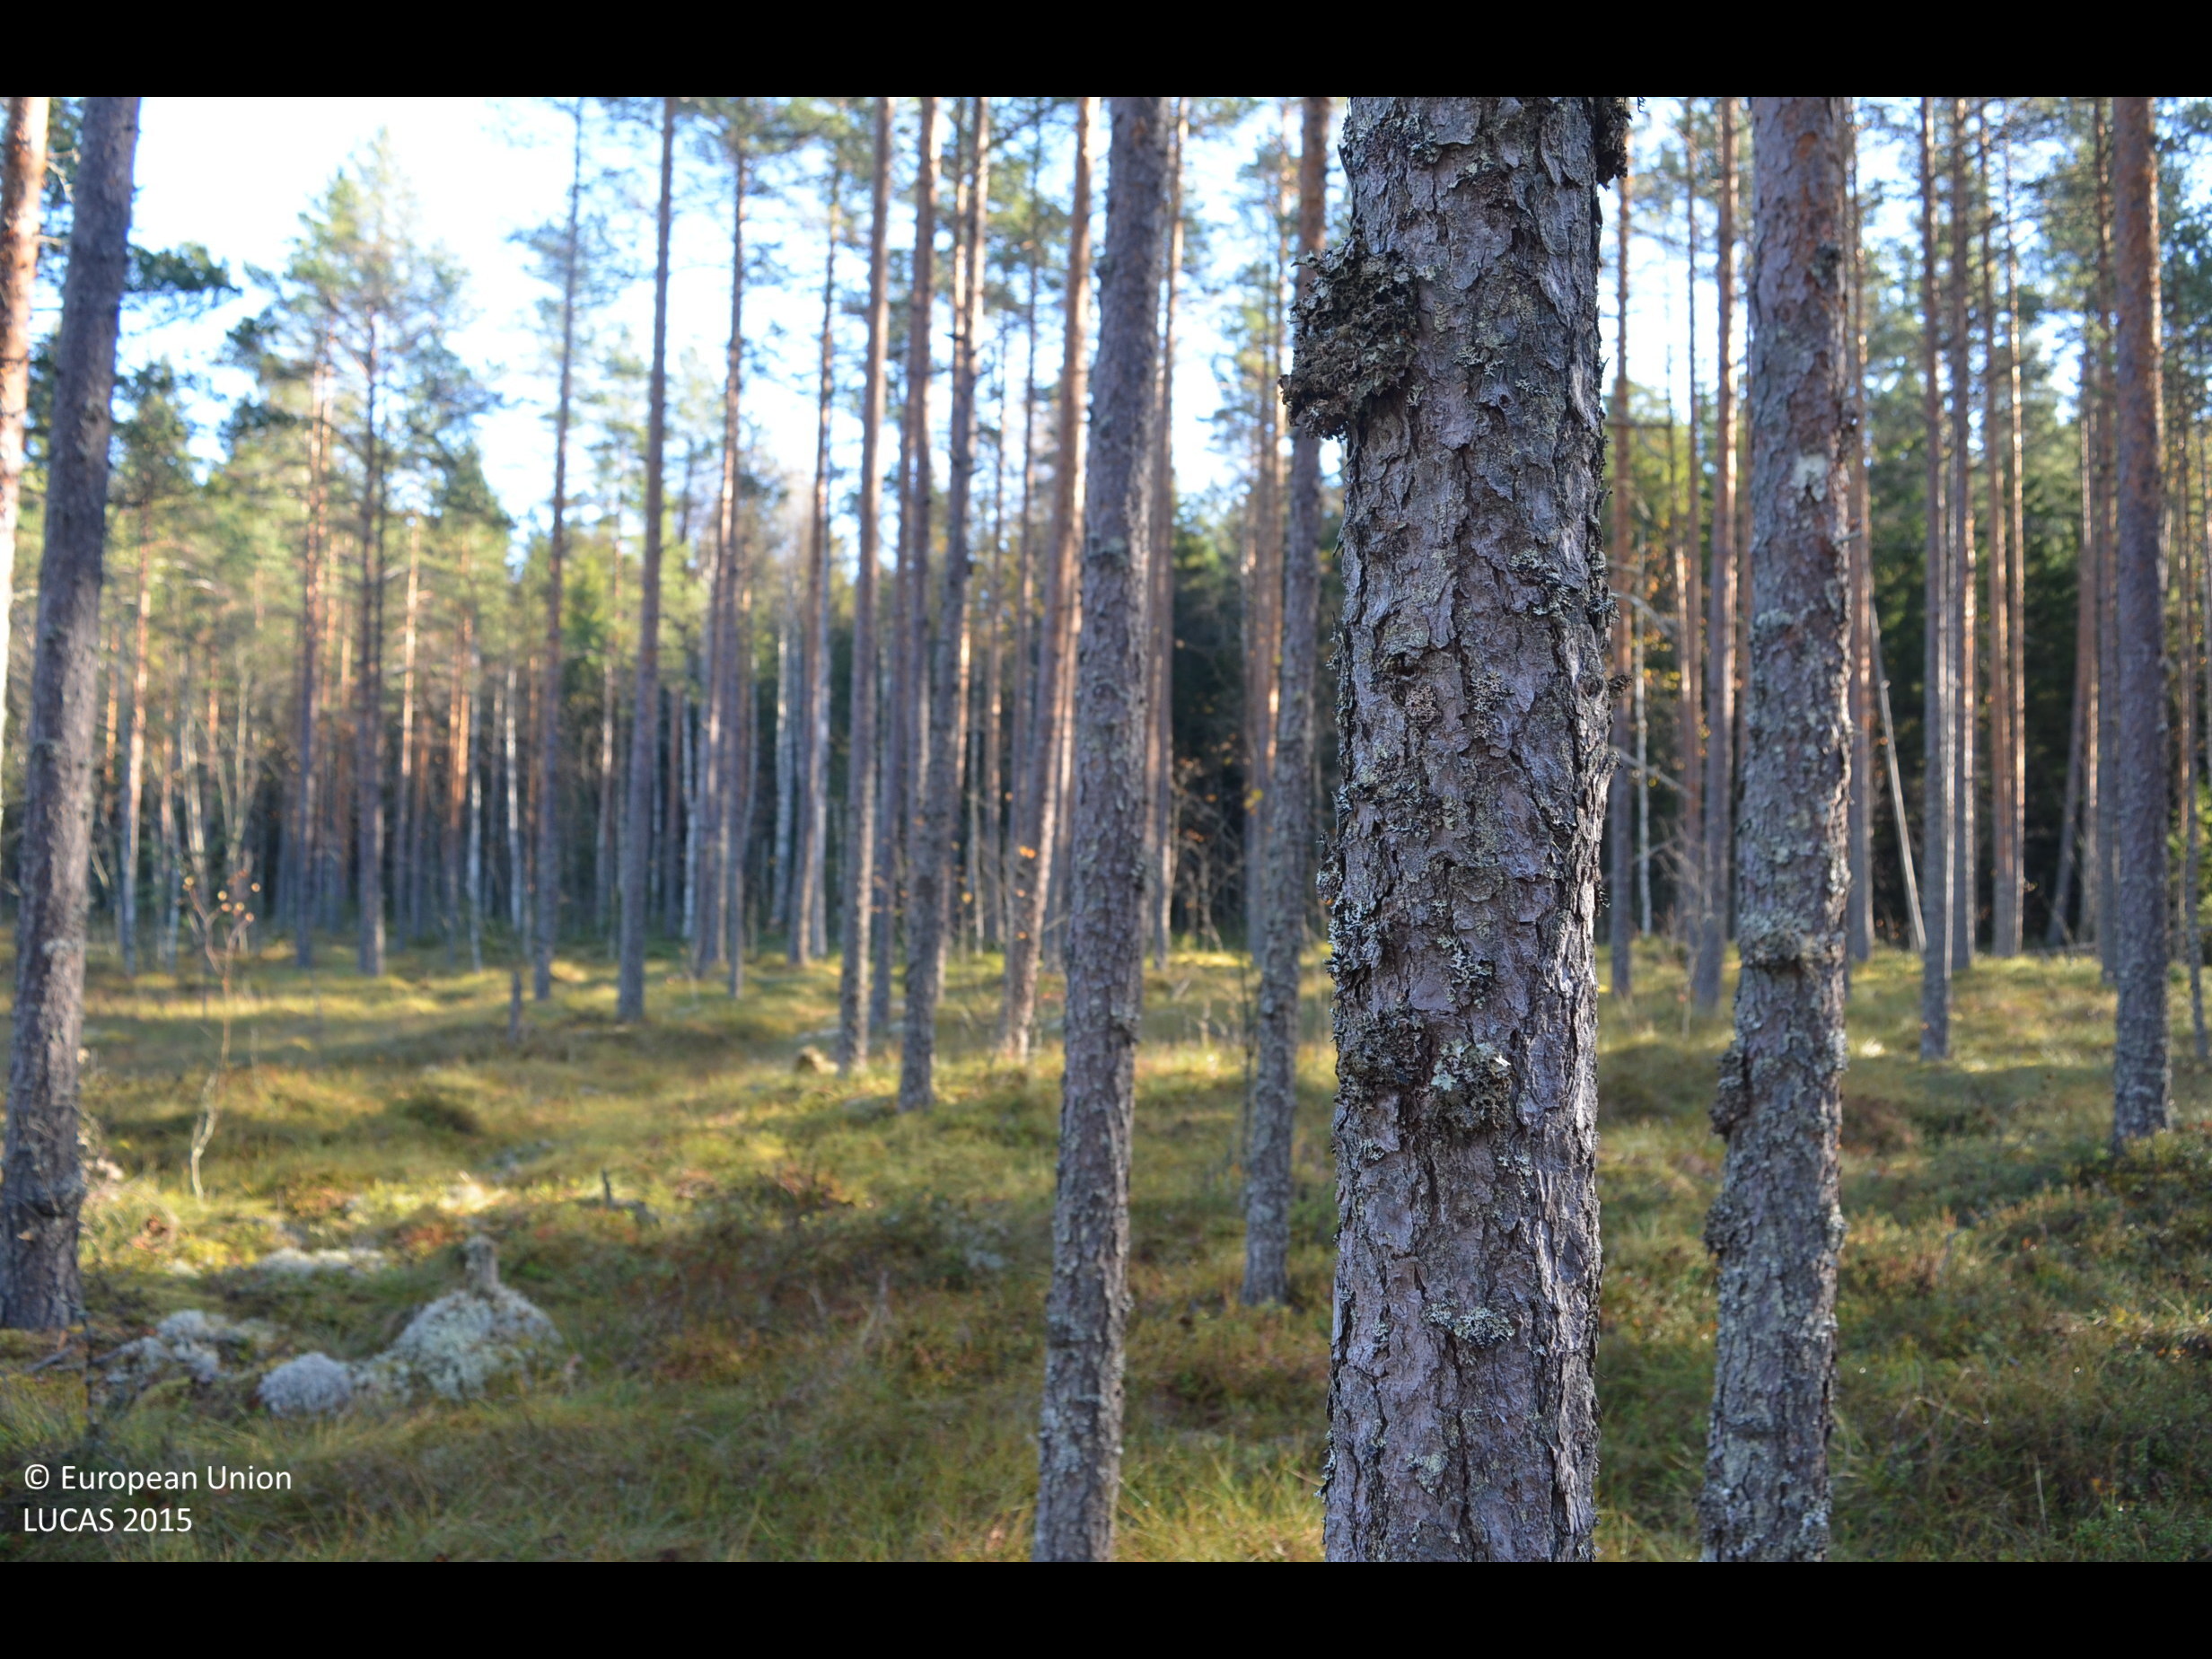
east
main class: Woodland
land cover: Pine dominated coniferous woodland
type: boreal forest
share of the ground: 50 - 75 %
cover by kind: coniferous forest trees 60 %, shrubs 15 %, lichens and mosses 15 %, herbaceous plants 10 %
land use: Forestry
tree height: > 5 m
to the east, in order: Pine dominated coniferous woodland; Other mixed woodland; Ditches and canals; Spruce dominated coniferous woodland; Ditches and canals; Spruce dominated coniferous woodland; Shrubland without tree cover; Spruce dominated coniferous woodland; Shrubland without tree cover
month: October
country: FI
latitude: 61.7935
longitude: 23.9490
